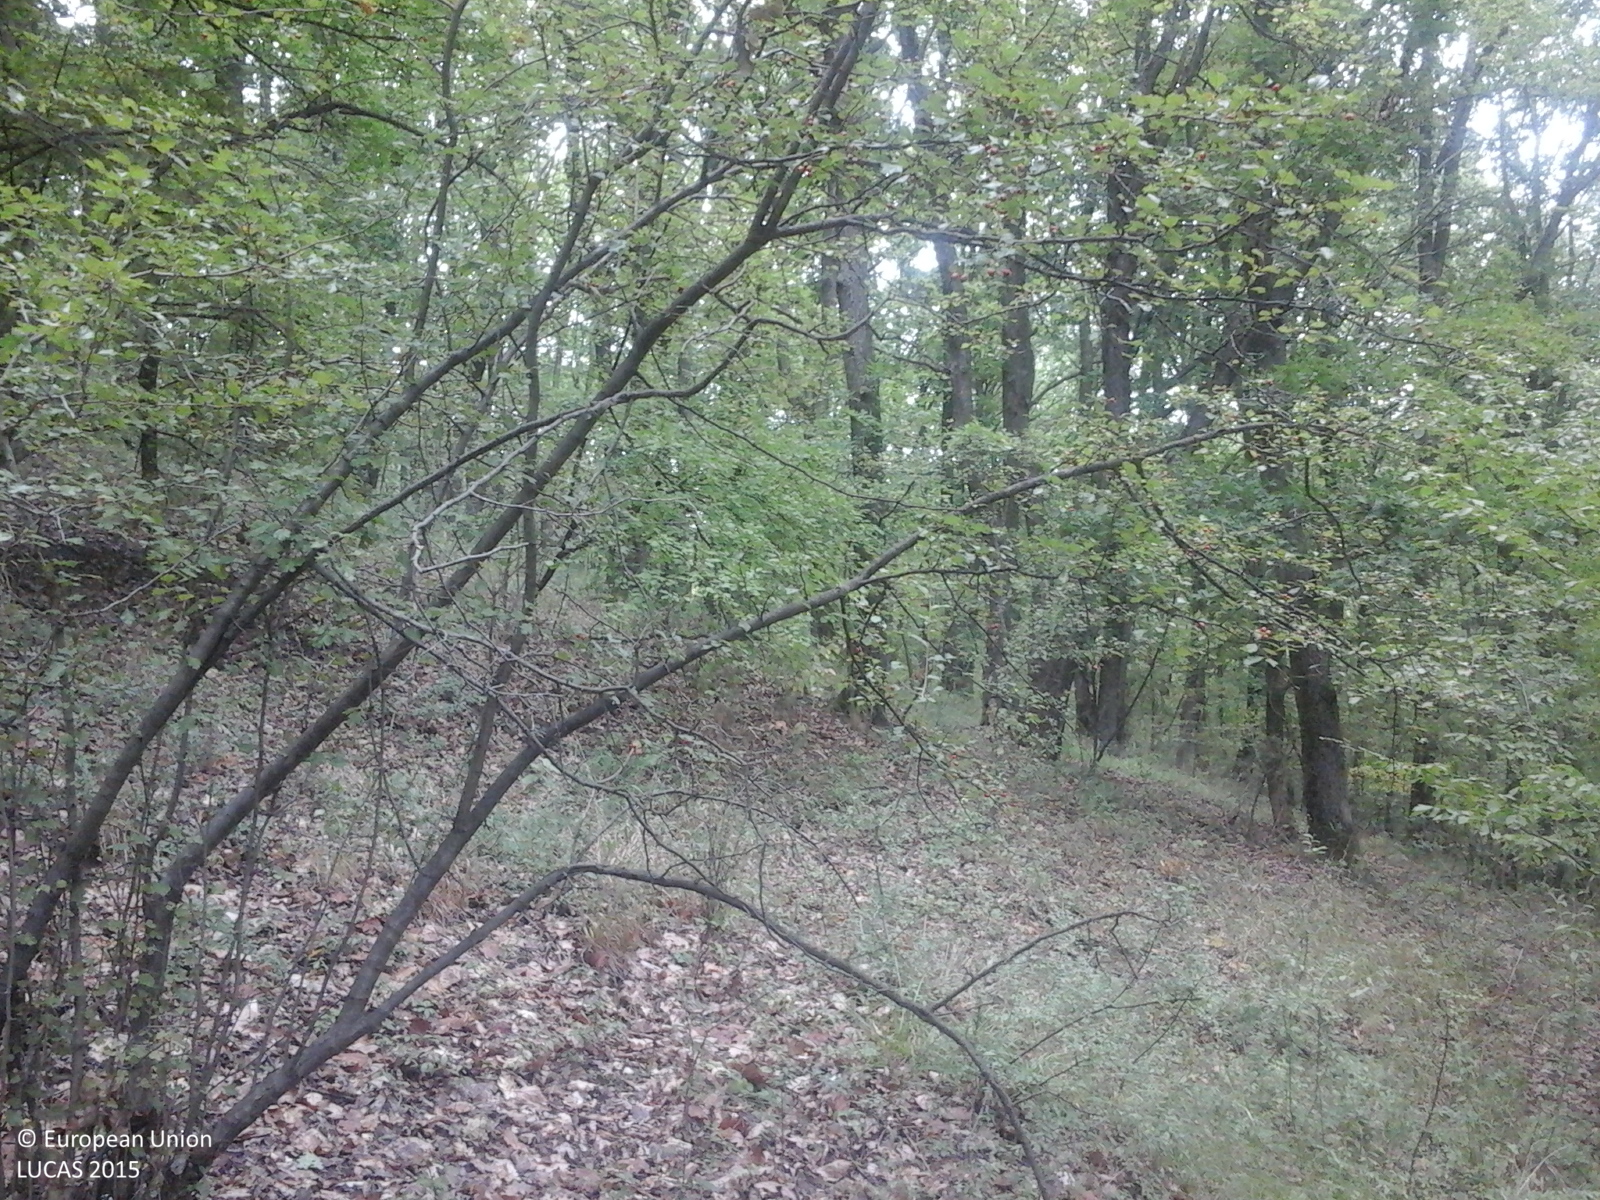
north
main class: Woodland
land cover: Broadleaved woodland
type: acidophilous oak and oak-birch forest
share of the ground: > 75 %
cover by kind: broadleaved forest trees 100 %
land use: Forestry
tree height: > 5 m
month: September
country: RO
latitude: 47.0781
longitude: 22.2868
